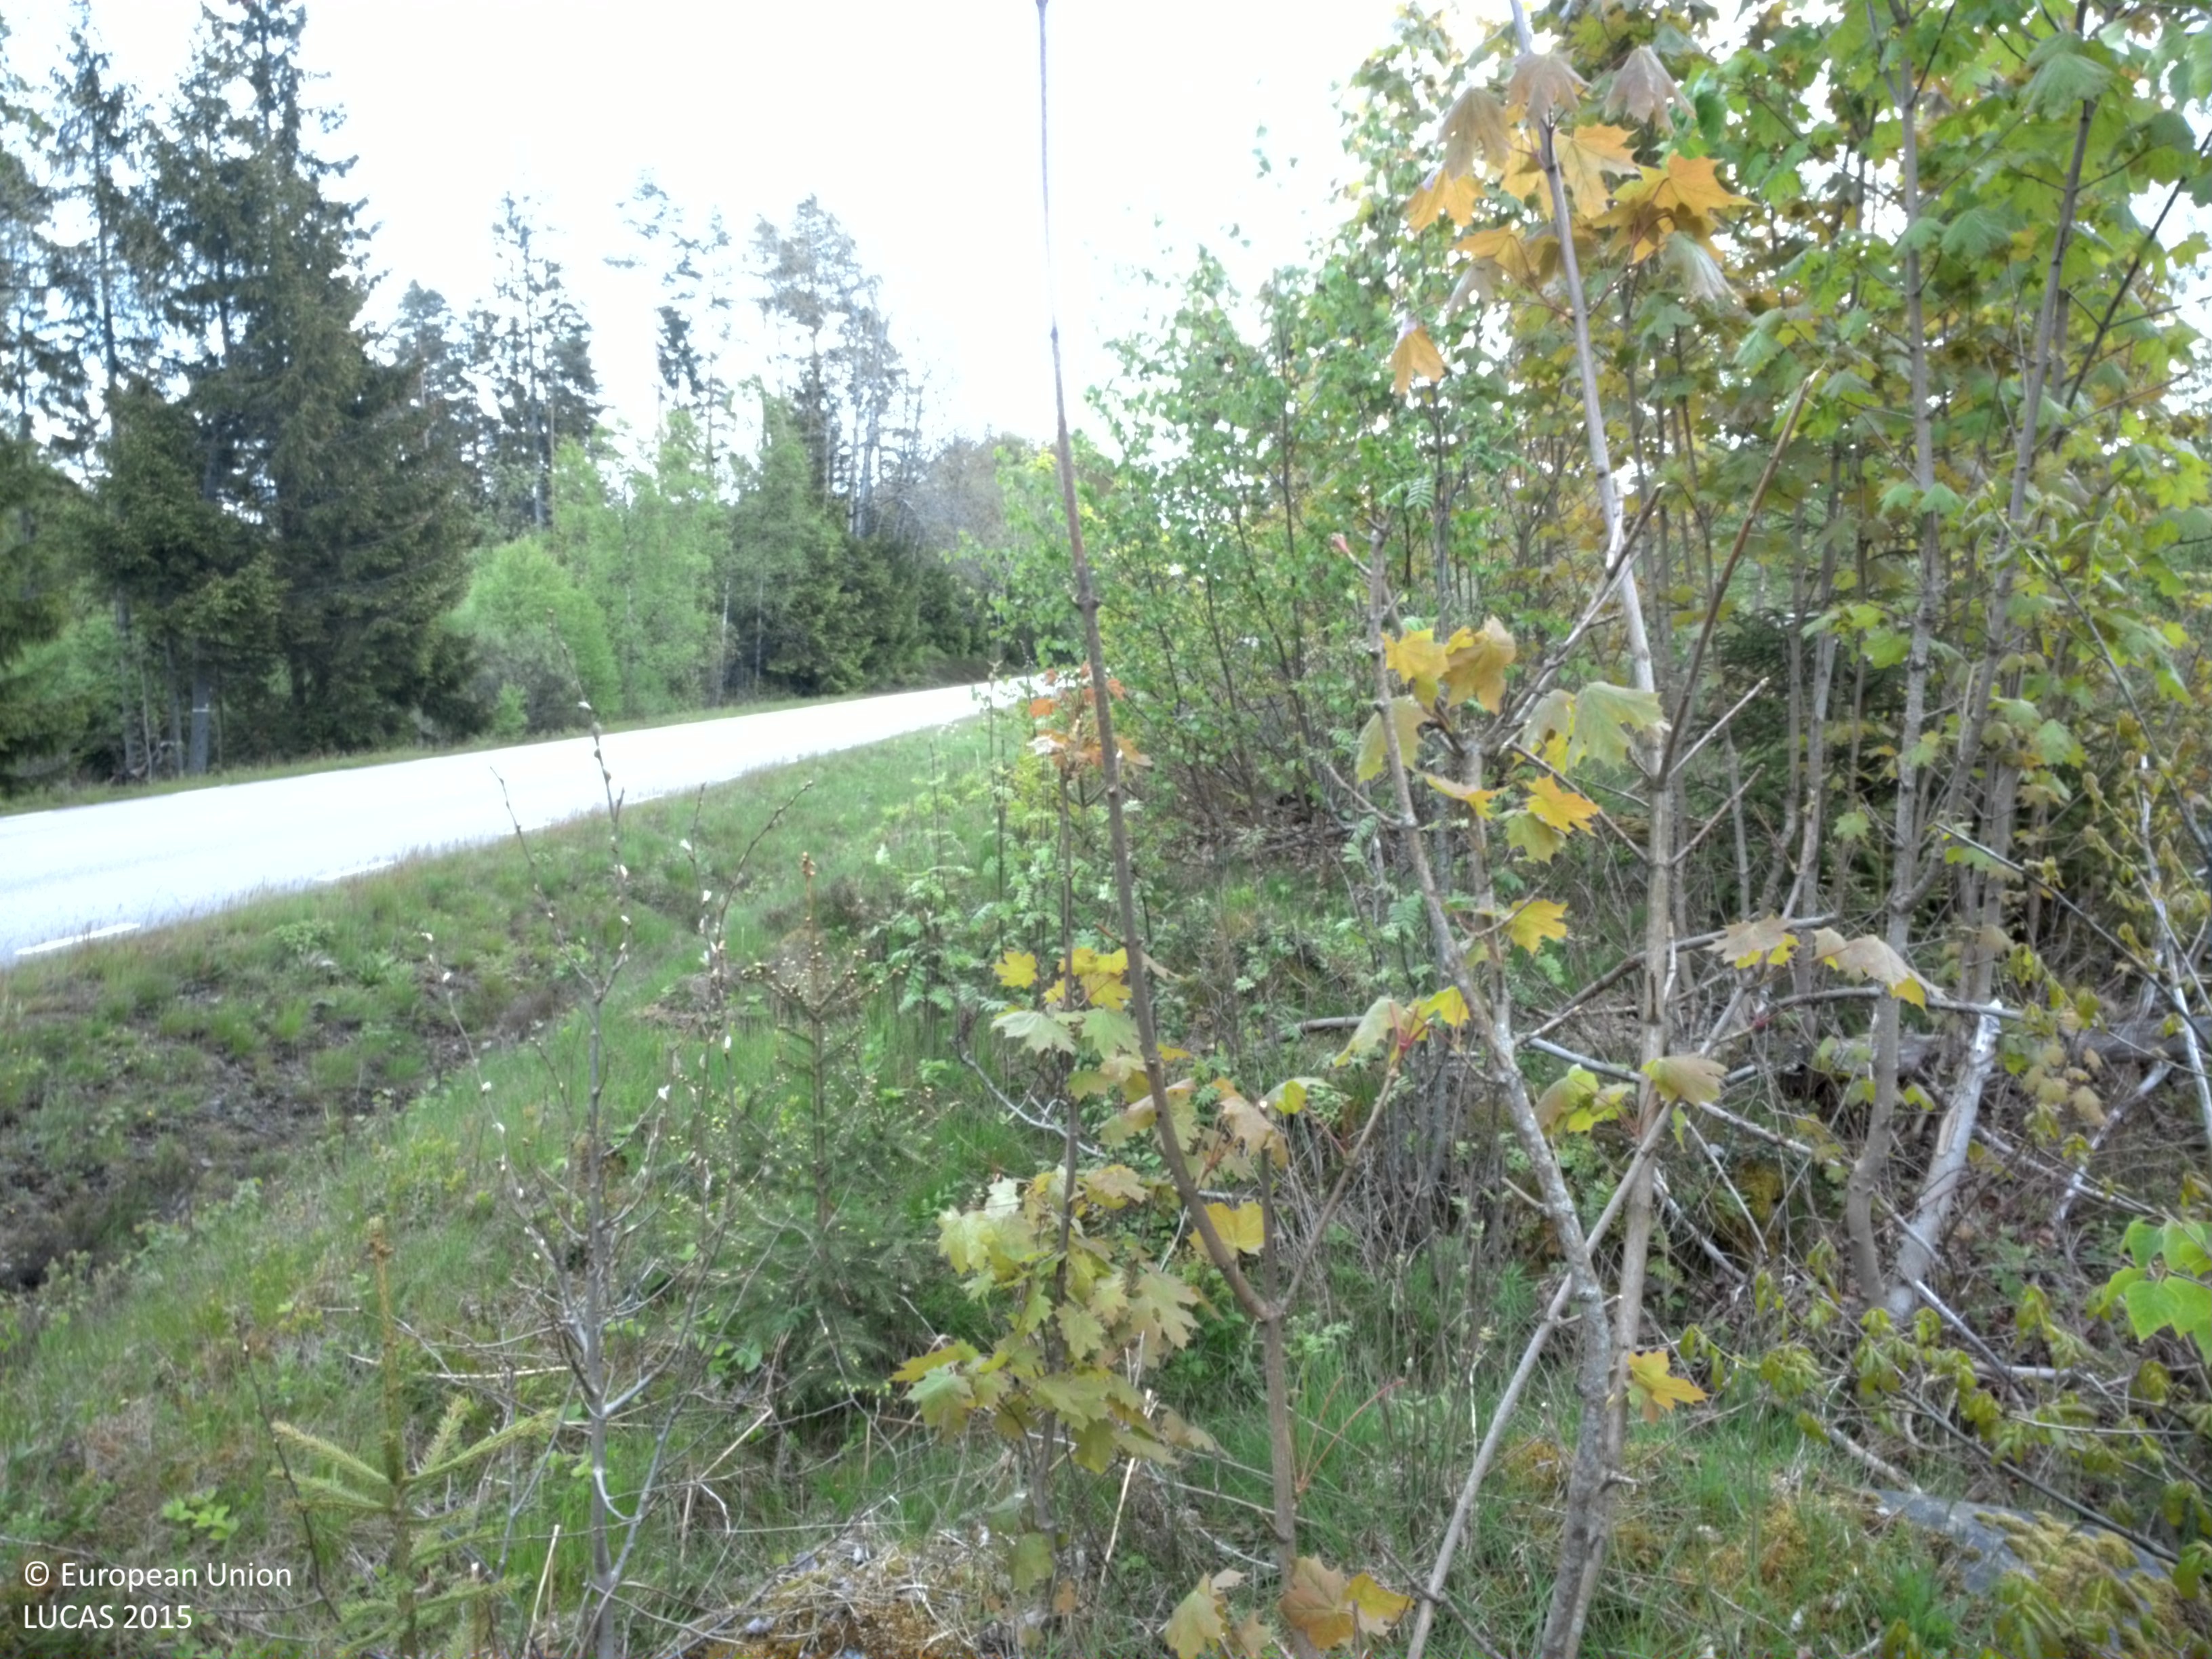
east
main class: Woodland
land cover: Spruce dominated mixed woodland
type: boreal forest
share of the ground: 50 - 75 %
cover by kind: broadleaved forest trees 35 %, coniferous forest trees 25 %, herbaceous plants 25 %, shrubs 10 %, lichens and mosses 5 %
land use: Forestry
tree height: < 5 m
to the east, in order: Spruce dominated mixed woodland; Shrubland with sparse tree cover; Paved roads, cycling and walking lanes; Shrubland with sparse tree cover; Spruce dominated mixed woodland
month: June
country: SE
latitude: 56.8178
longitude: 14.3054
